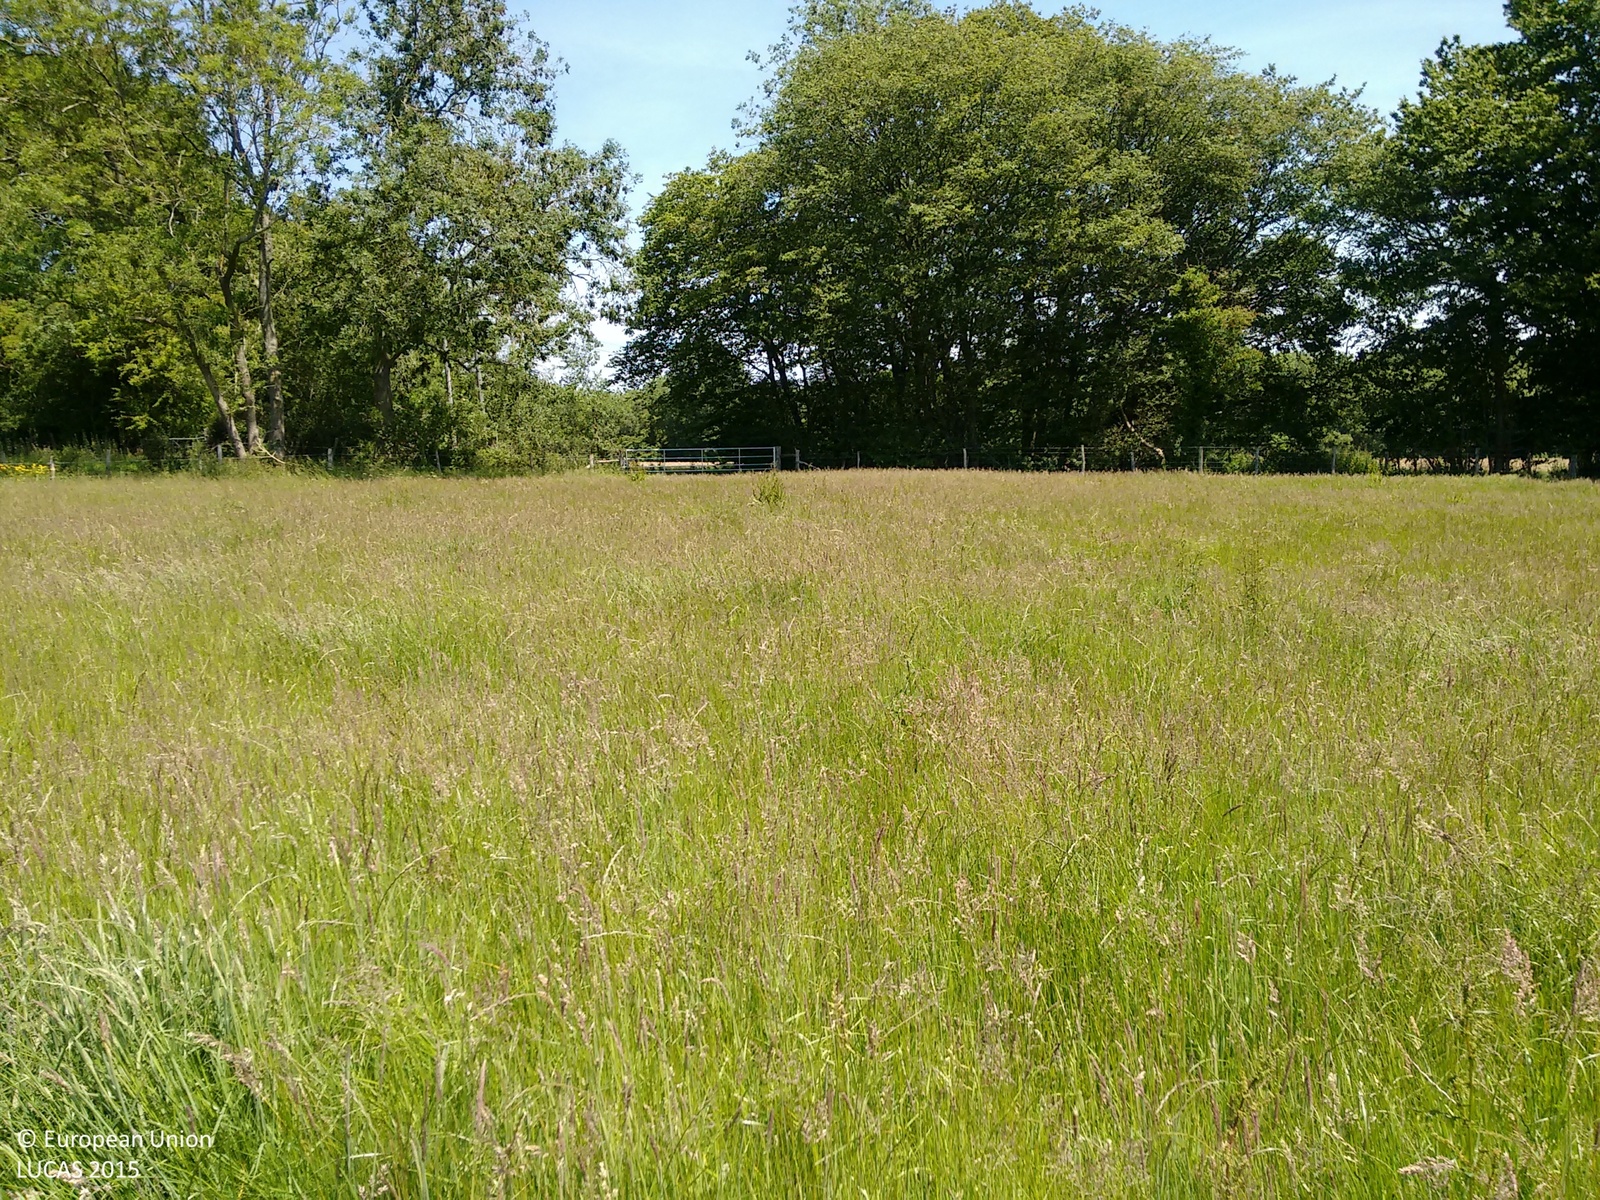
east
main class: Grassland
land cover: Grassland without tree/shrub cover
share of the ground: > 75 %
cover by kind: herbaceous plants 100 %
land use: Agriculture (excluding fallow land and kitchen gardens)
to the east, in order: Grassland without tree/shrub cover; Fences; Broadleaved woodland; Grass margins; Other bare soil; Electric lines; Other bare soil; Grassland without tree/shrub cover; Broadleaved woodland; Fences; Broadleaved woodland
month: June
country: GB
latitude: 51.0460
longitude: 0.4002
